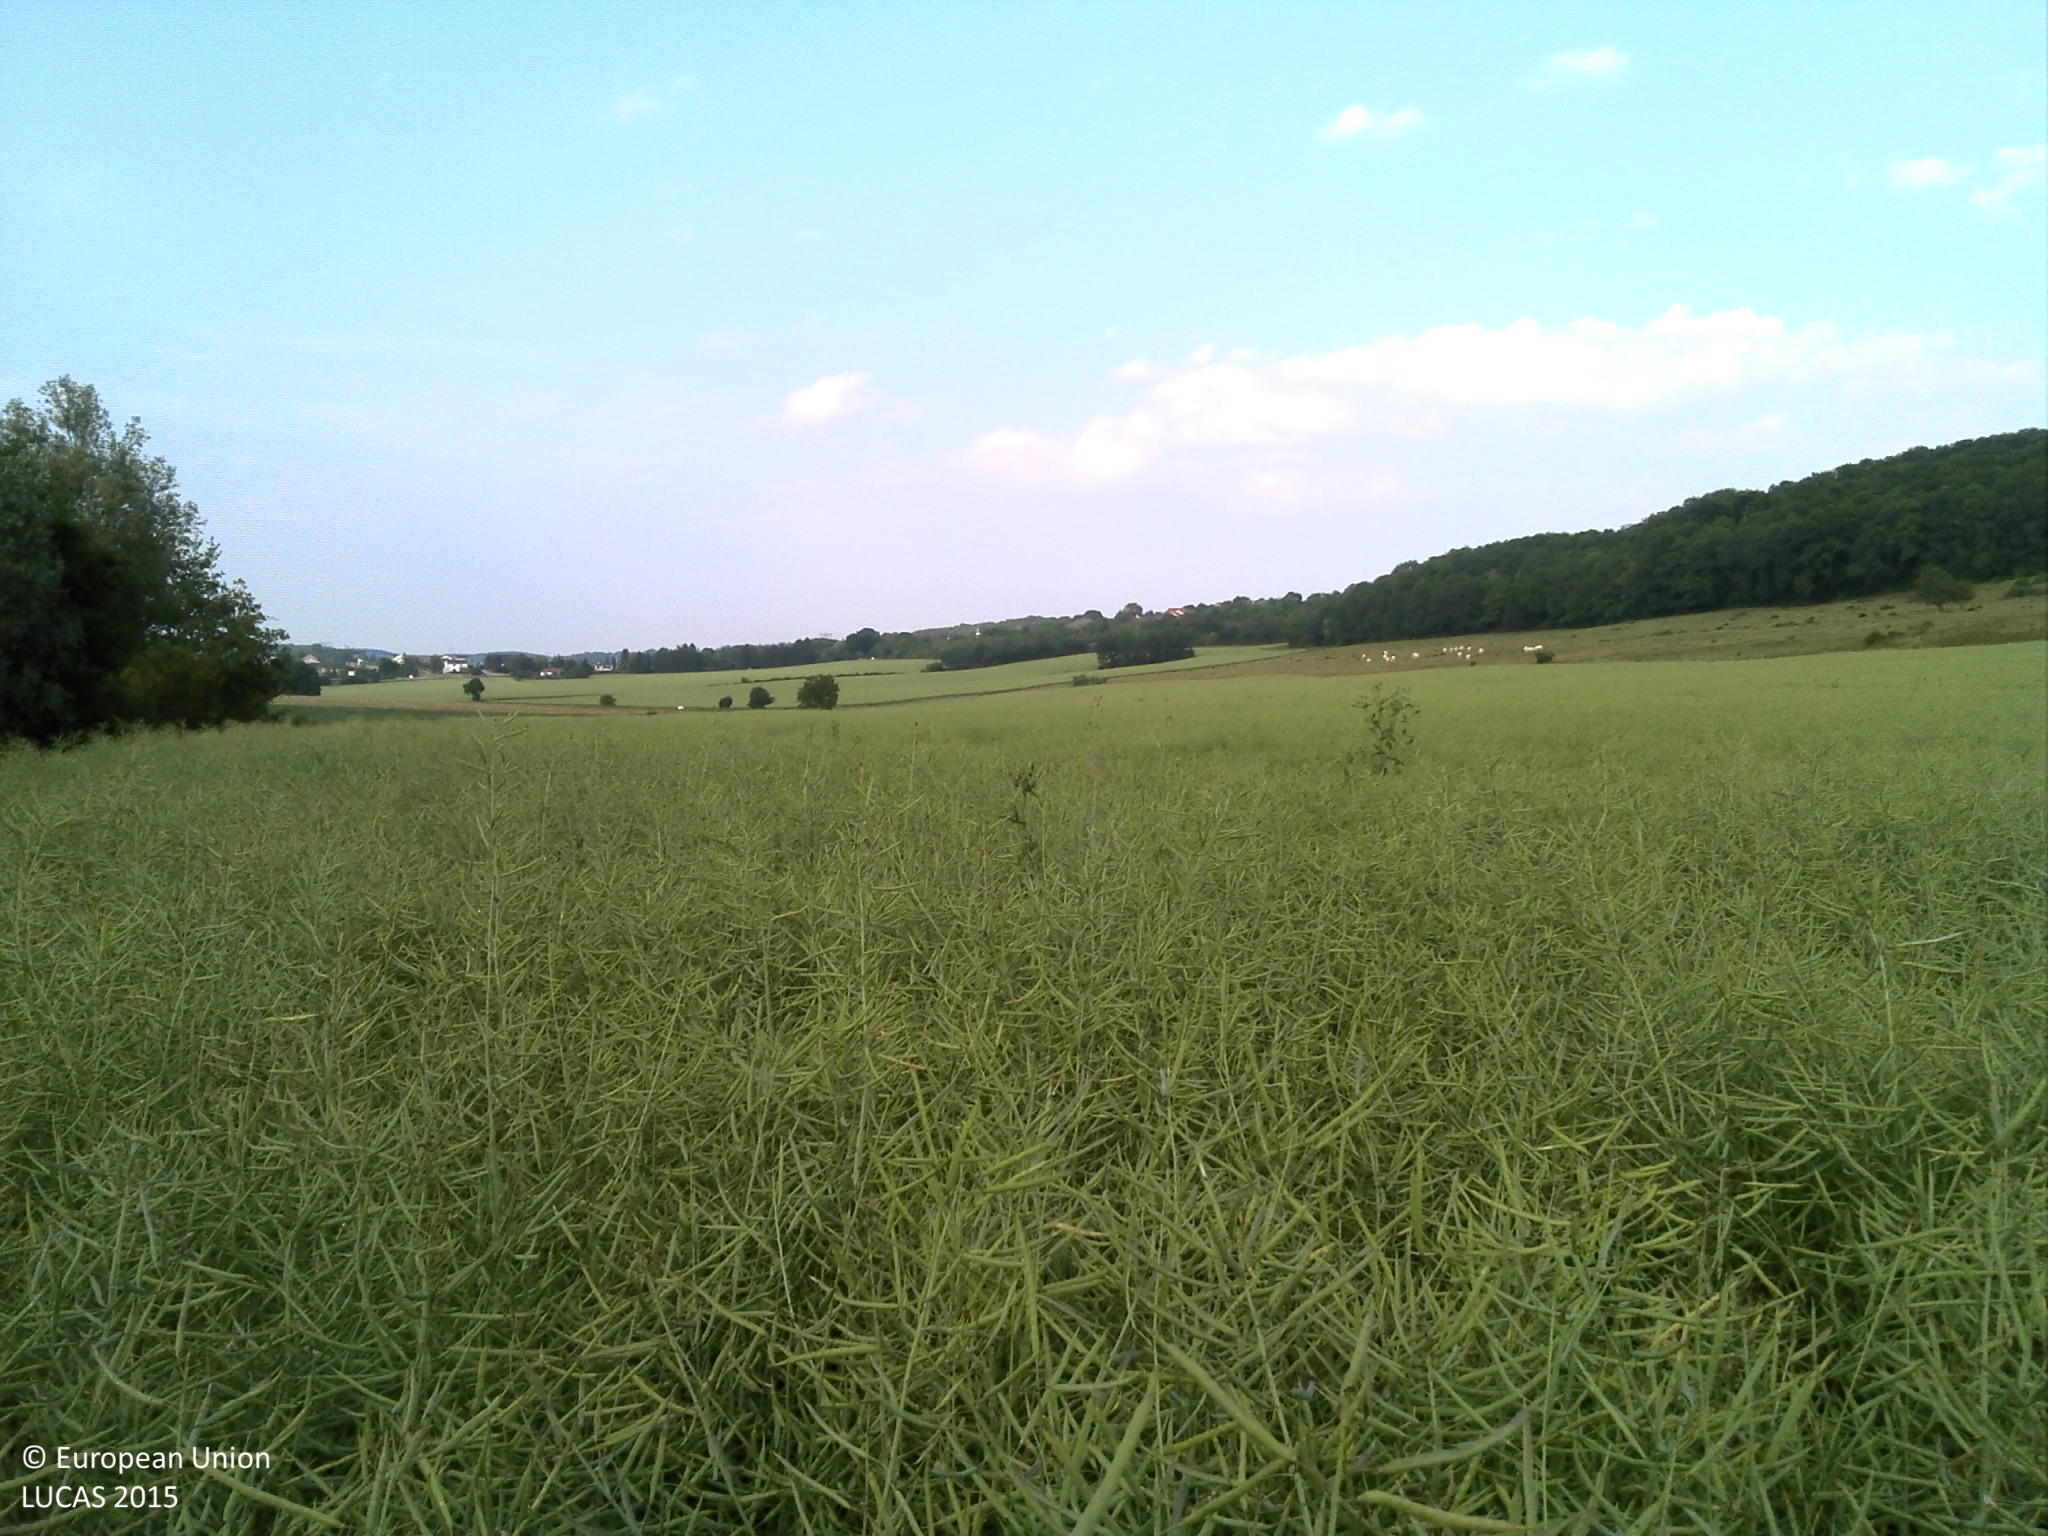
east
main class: Cropland
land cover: Rape and turnip rape
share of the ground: > 75 %
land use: Agriculture (excluding fallow land and kitchen gardens)
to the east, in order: Rape and turnip rape
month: June
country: FR
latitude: 49.1497
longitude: 6.2295
